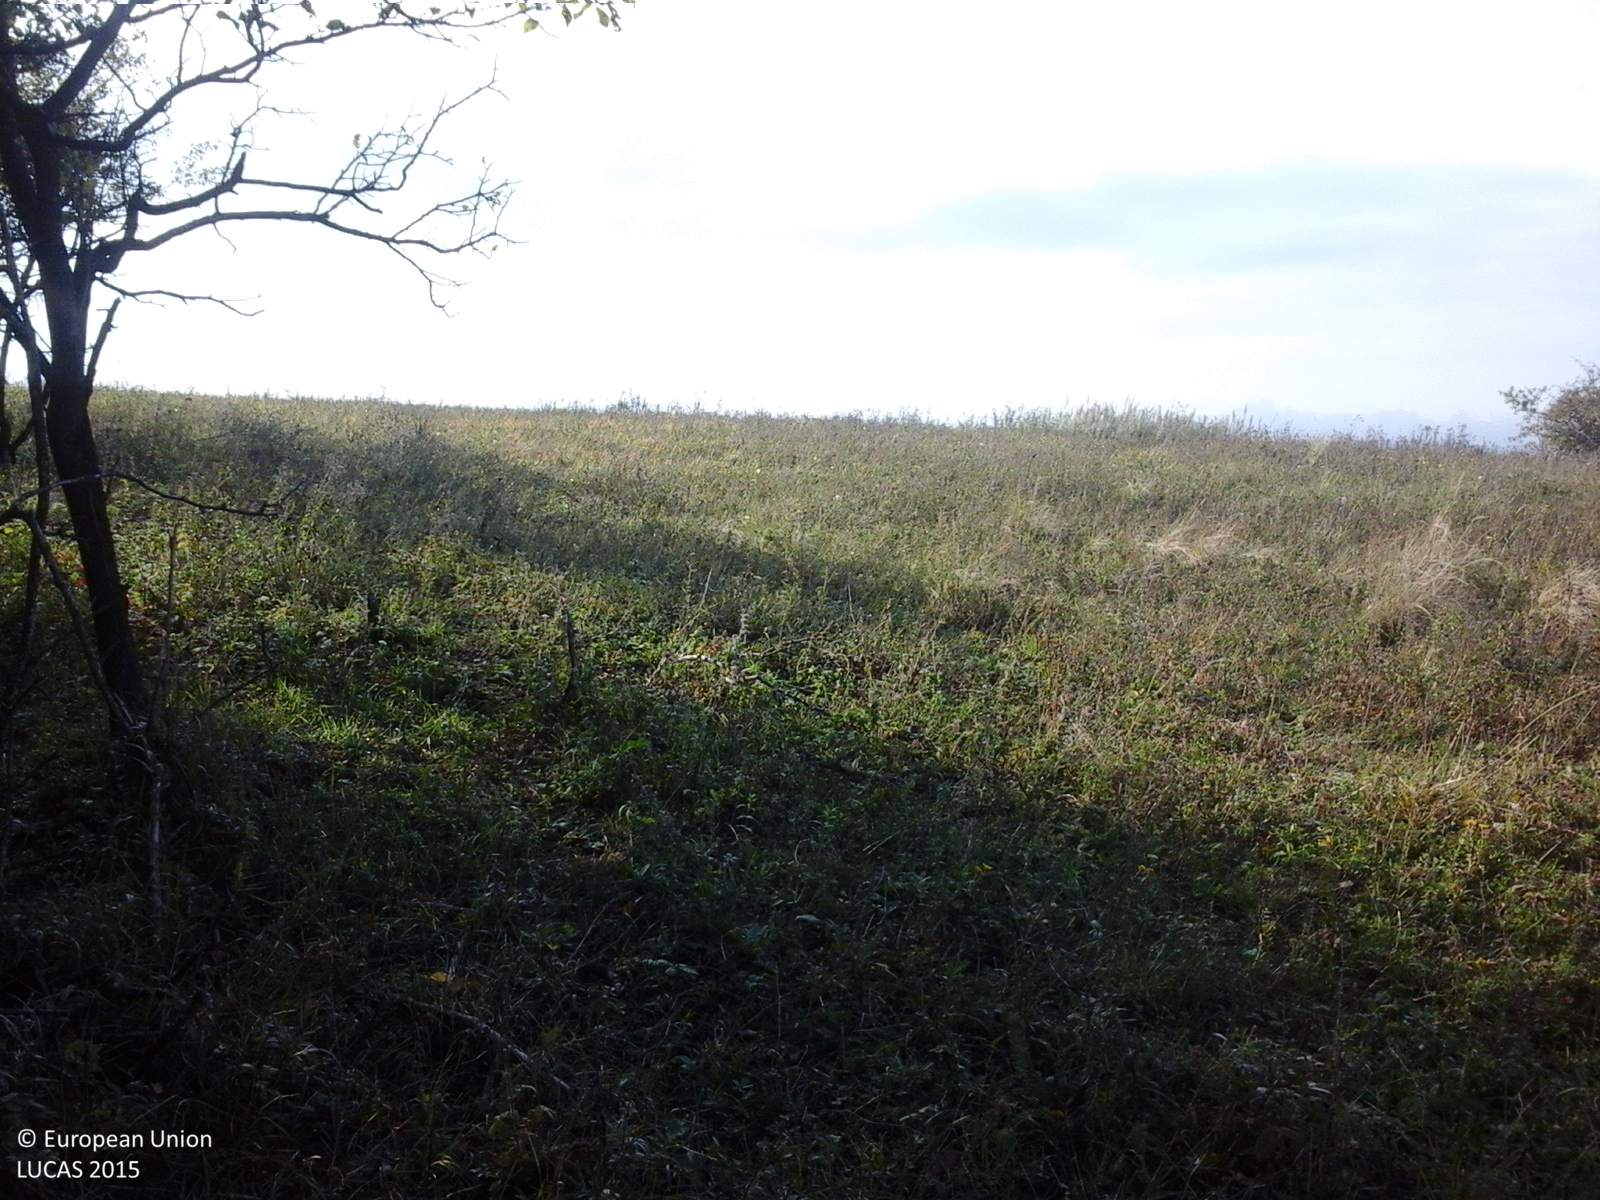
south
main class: Shrubland
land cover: Shrubland without tree cover
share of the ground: > 75 %
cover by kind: shrubs 100 %
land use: Semi-natural and natural areas not in use
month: October
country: RO
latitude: 46.3851
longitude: 23.9227
